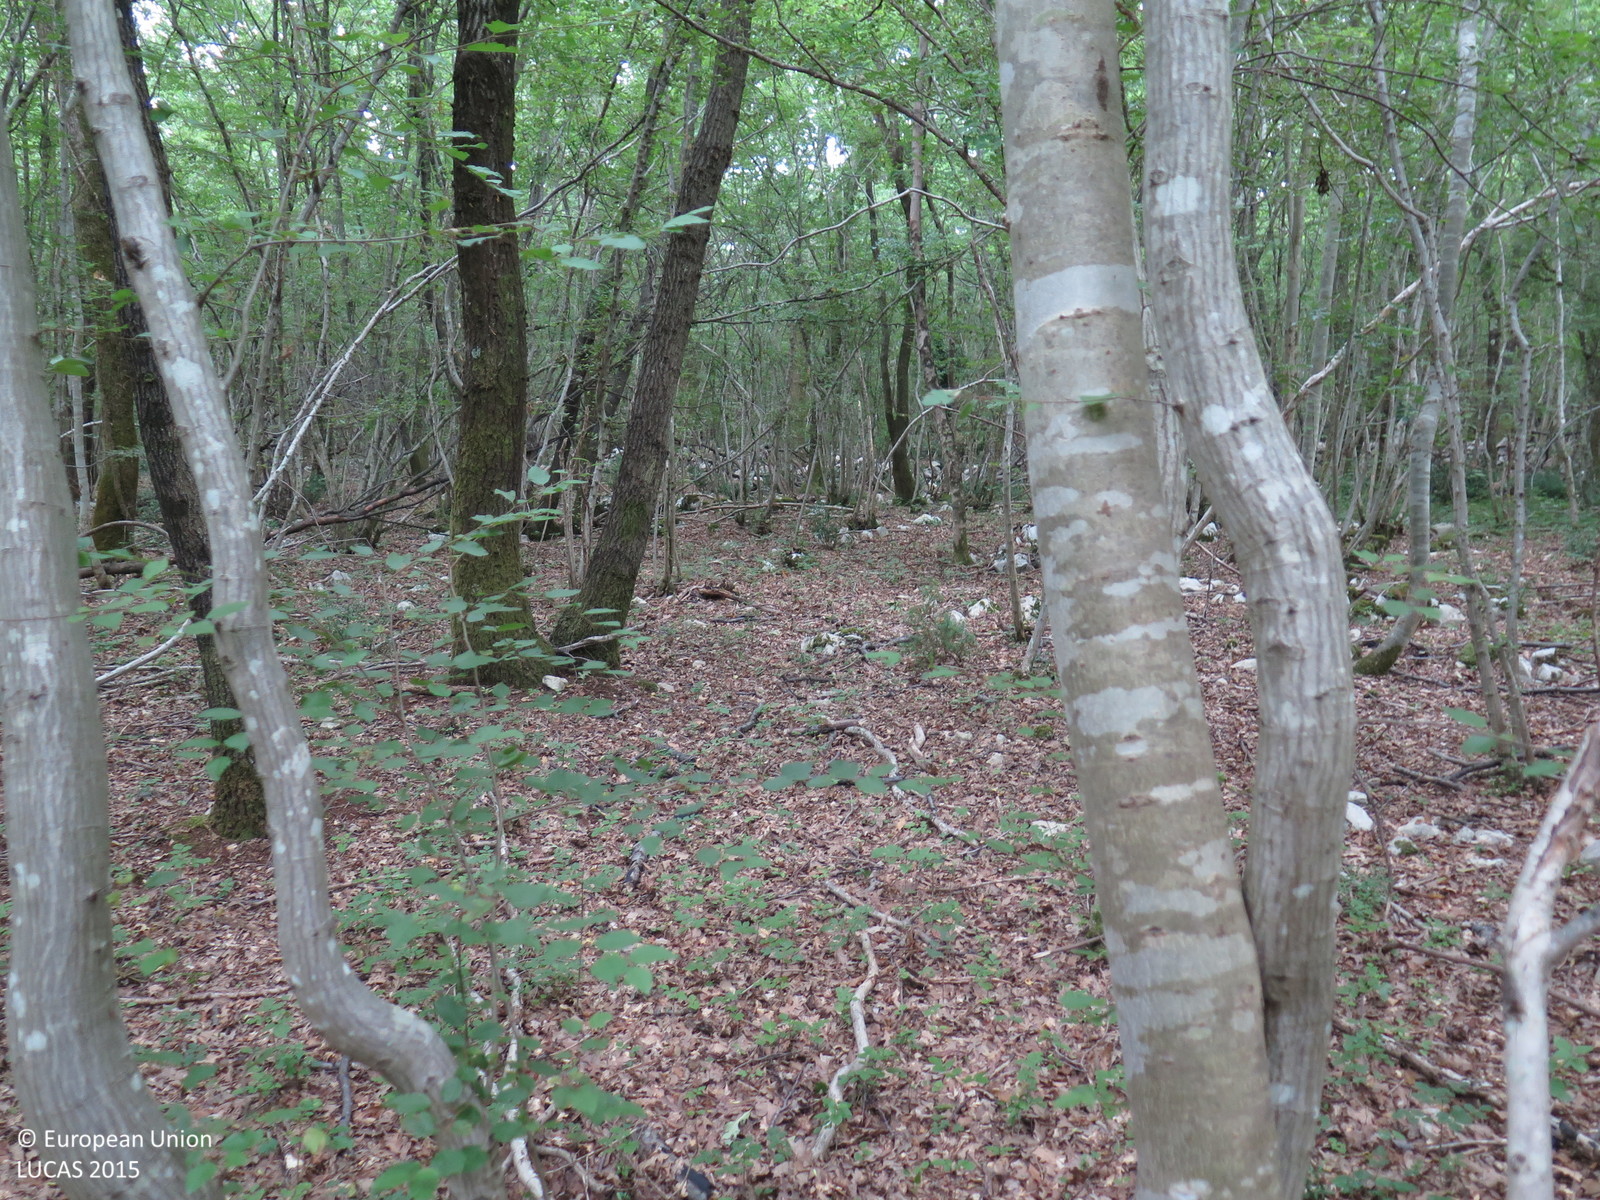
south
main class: Woodland
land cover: Broadleaved woodland
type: beech forest
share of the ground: > 75 %
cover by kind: broadleaved forest trees 100 %
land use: Semi-natural and natural areas not in use
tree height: > 5 m
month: August
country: HR
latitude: 45.1139
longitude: 14.6341
